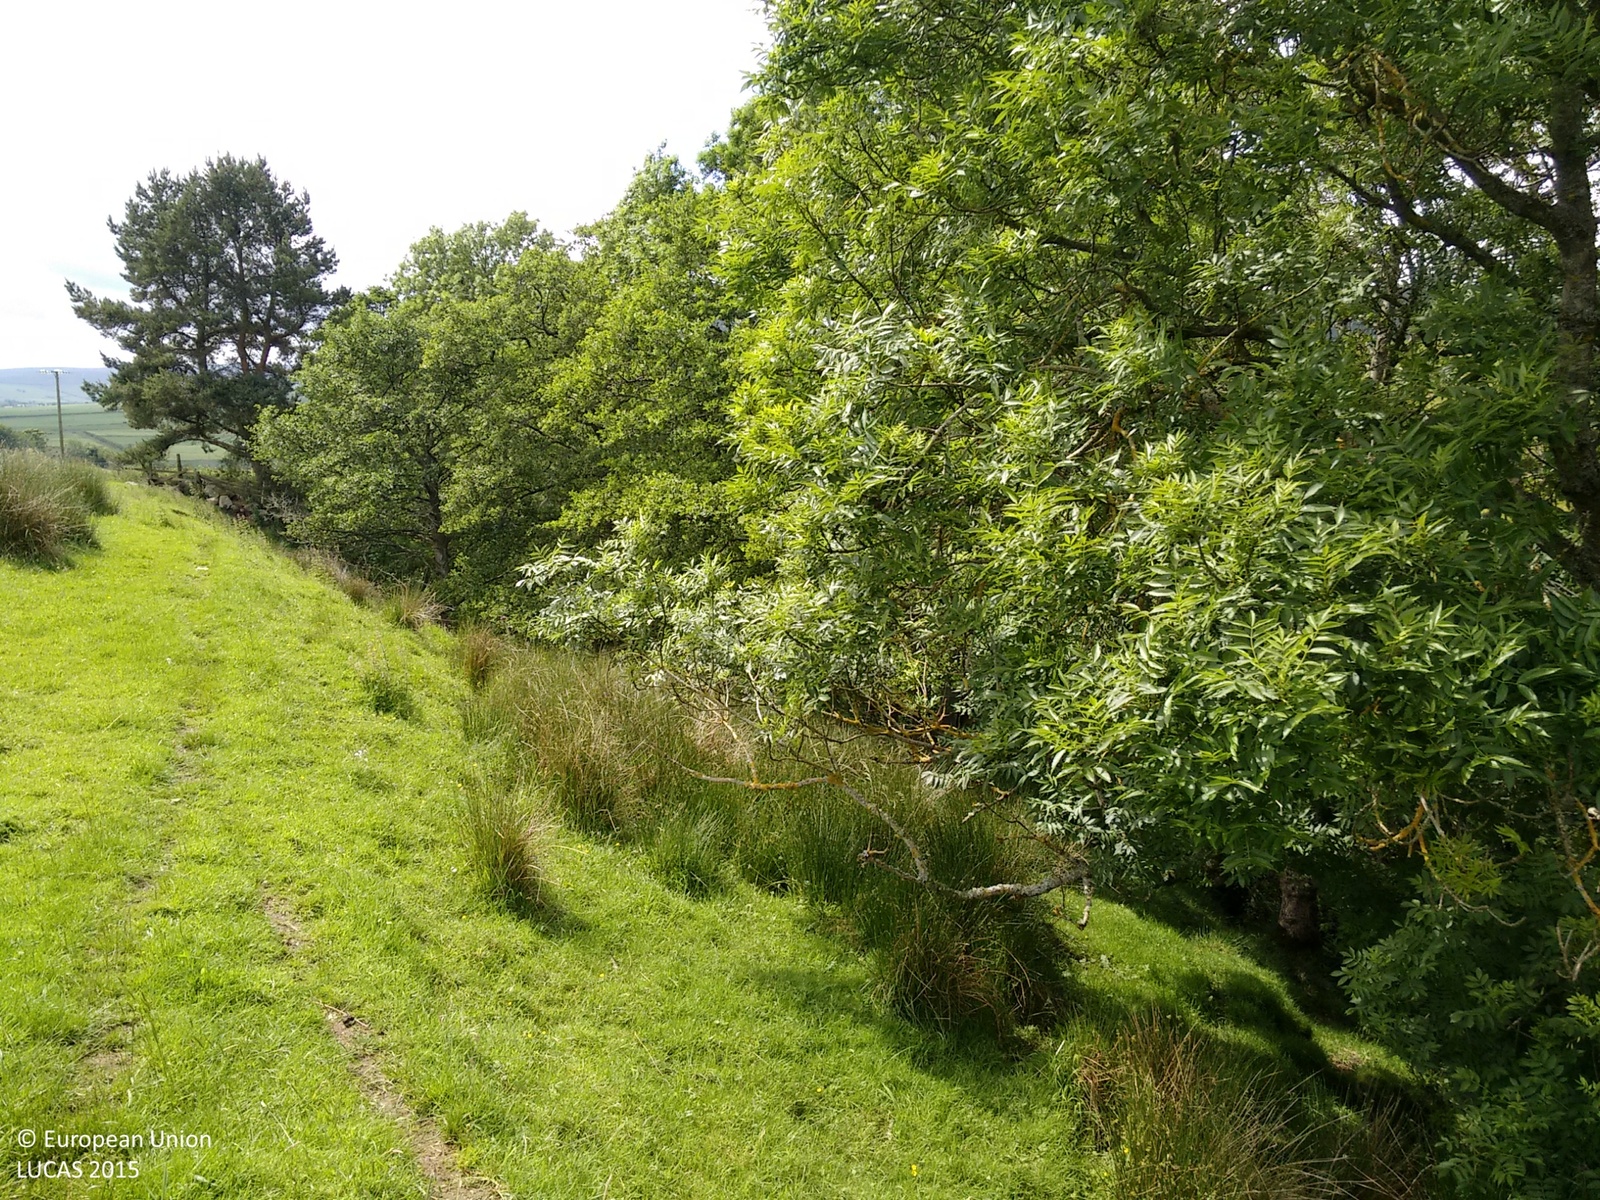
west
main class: Grassland
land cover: Grassland without tree/shrub cover
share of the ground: > 75 %
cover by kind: herbaceous plants 100 %
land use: Agriculture (excluding fallow land and kitchen gardens)
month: July
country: GB
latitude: 57.3691
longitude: -2.7782
